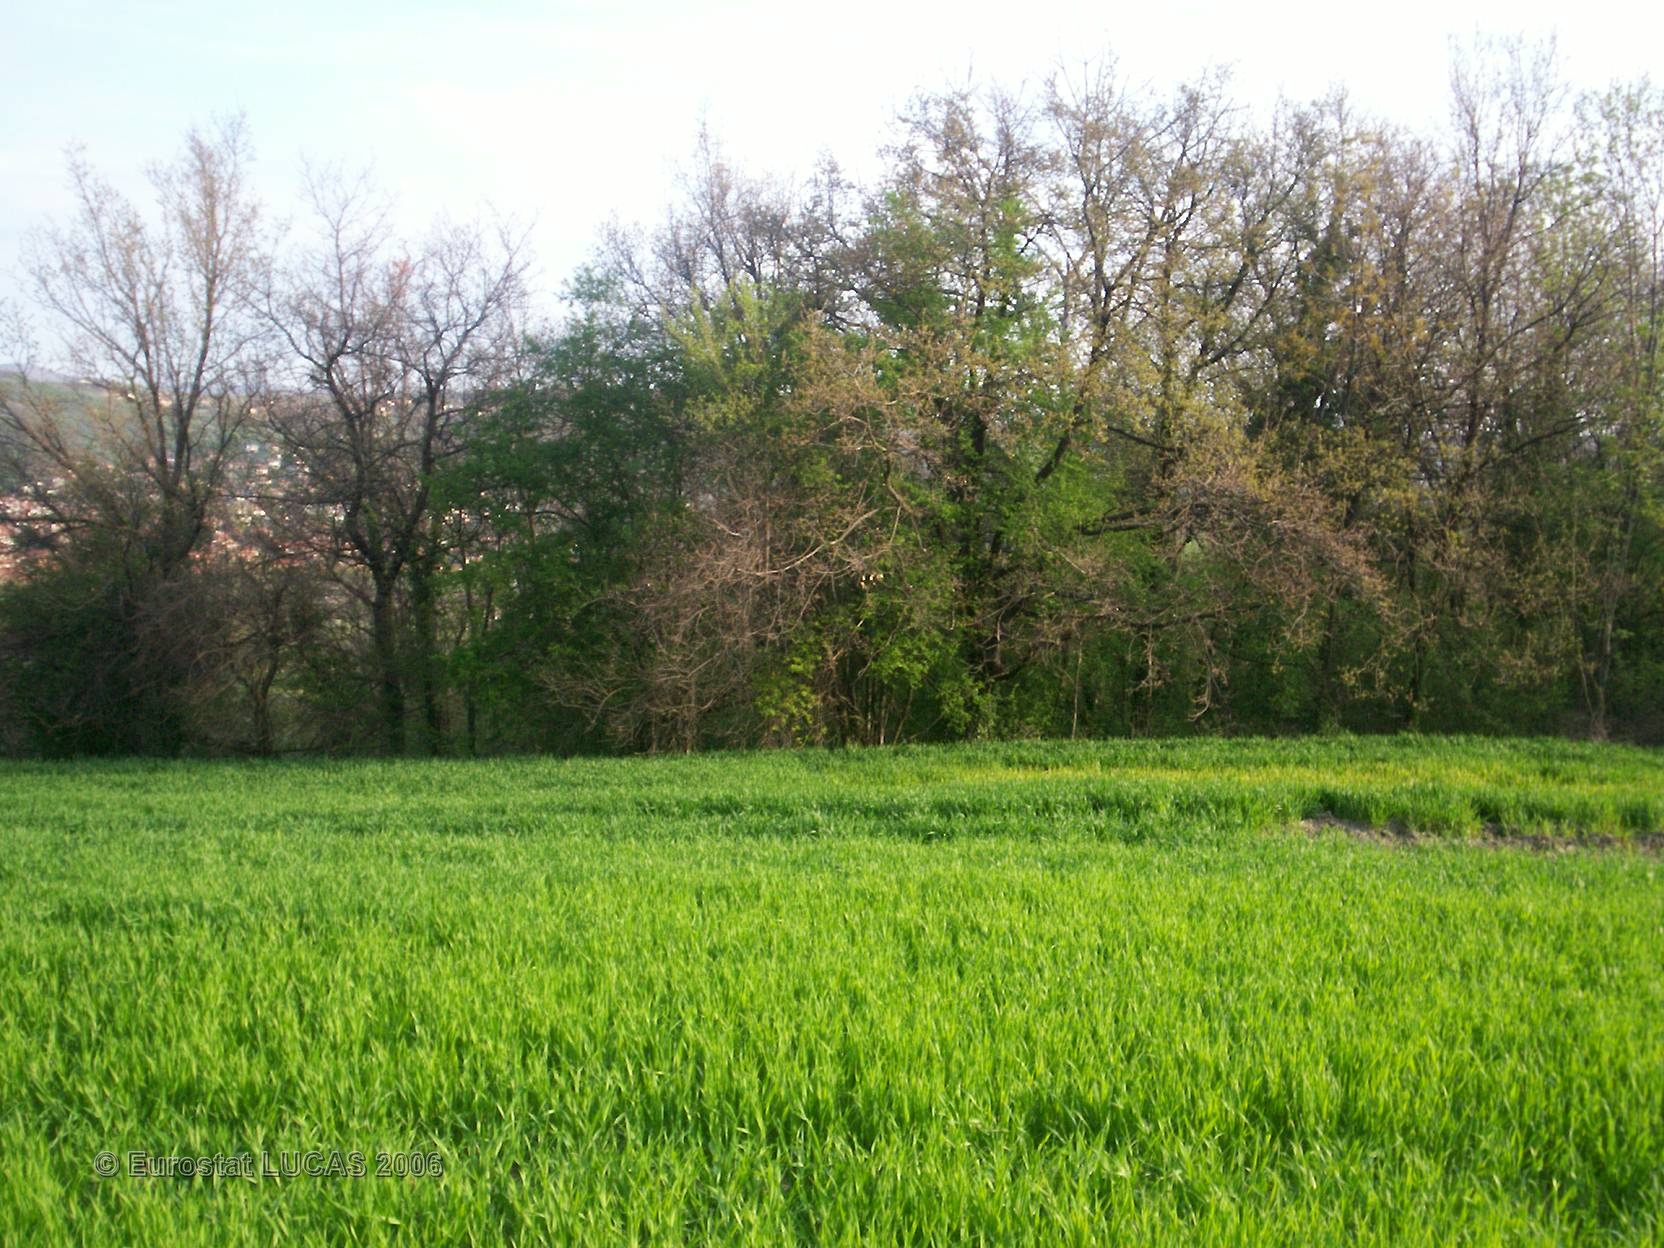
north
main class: Cropland
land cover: Common wheat
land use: Agriculture (excluding fallow land and kitchen gardens)
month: April
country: FR
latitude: 45.8202
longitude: 3.0879
